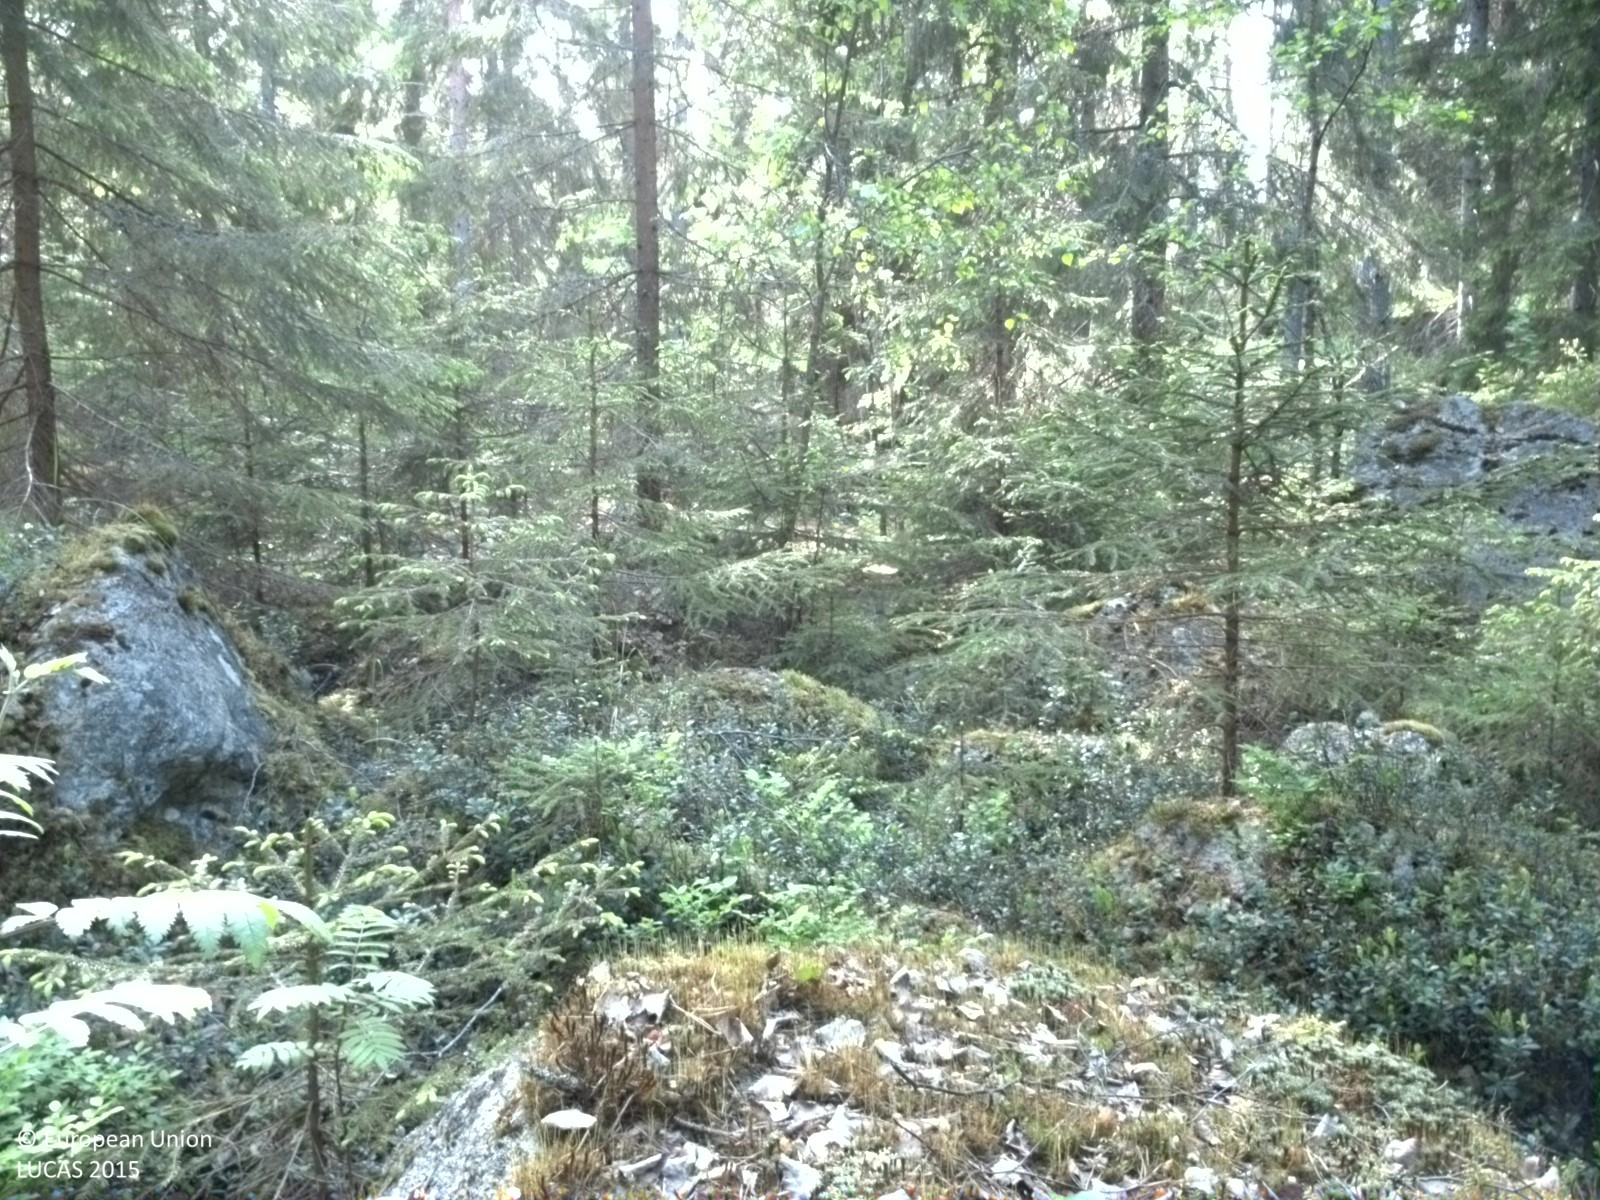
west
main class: Woodland
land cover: Spruce dominated coniferous woodland
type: boreal forest
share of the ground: > 75 %
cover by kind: coniferous forest trees 75 %, shrubs 10 %, broadleaved forest trees 5 %, herbaceous plants 5 %, lichens and mosses 5 %
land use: Forestry
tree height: > 5 m
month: June
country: SE
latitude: 60.2875
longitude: 17.1716
